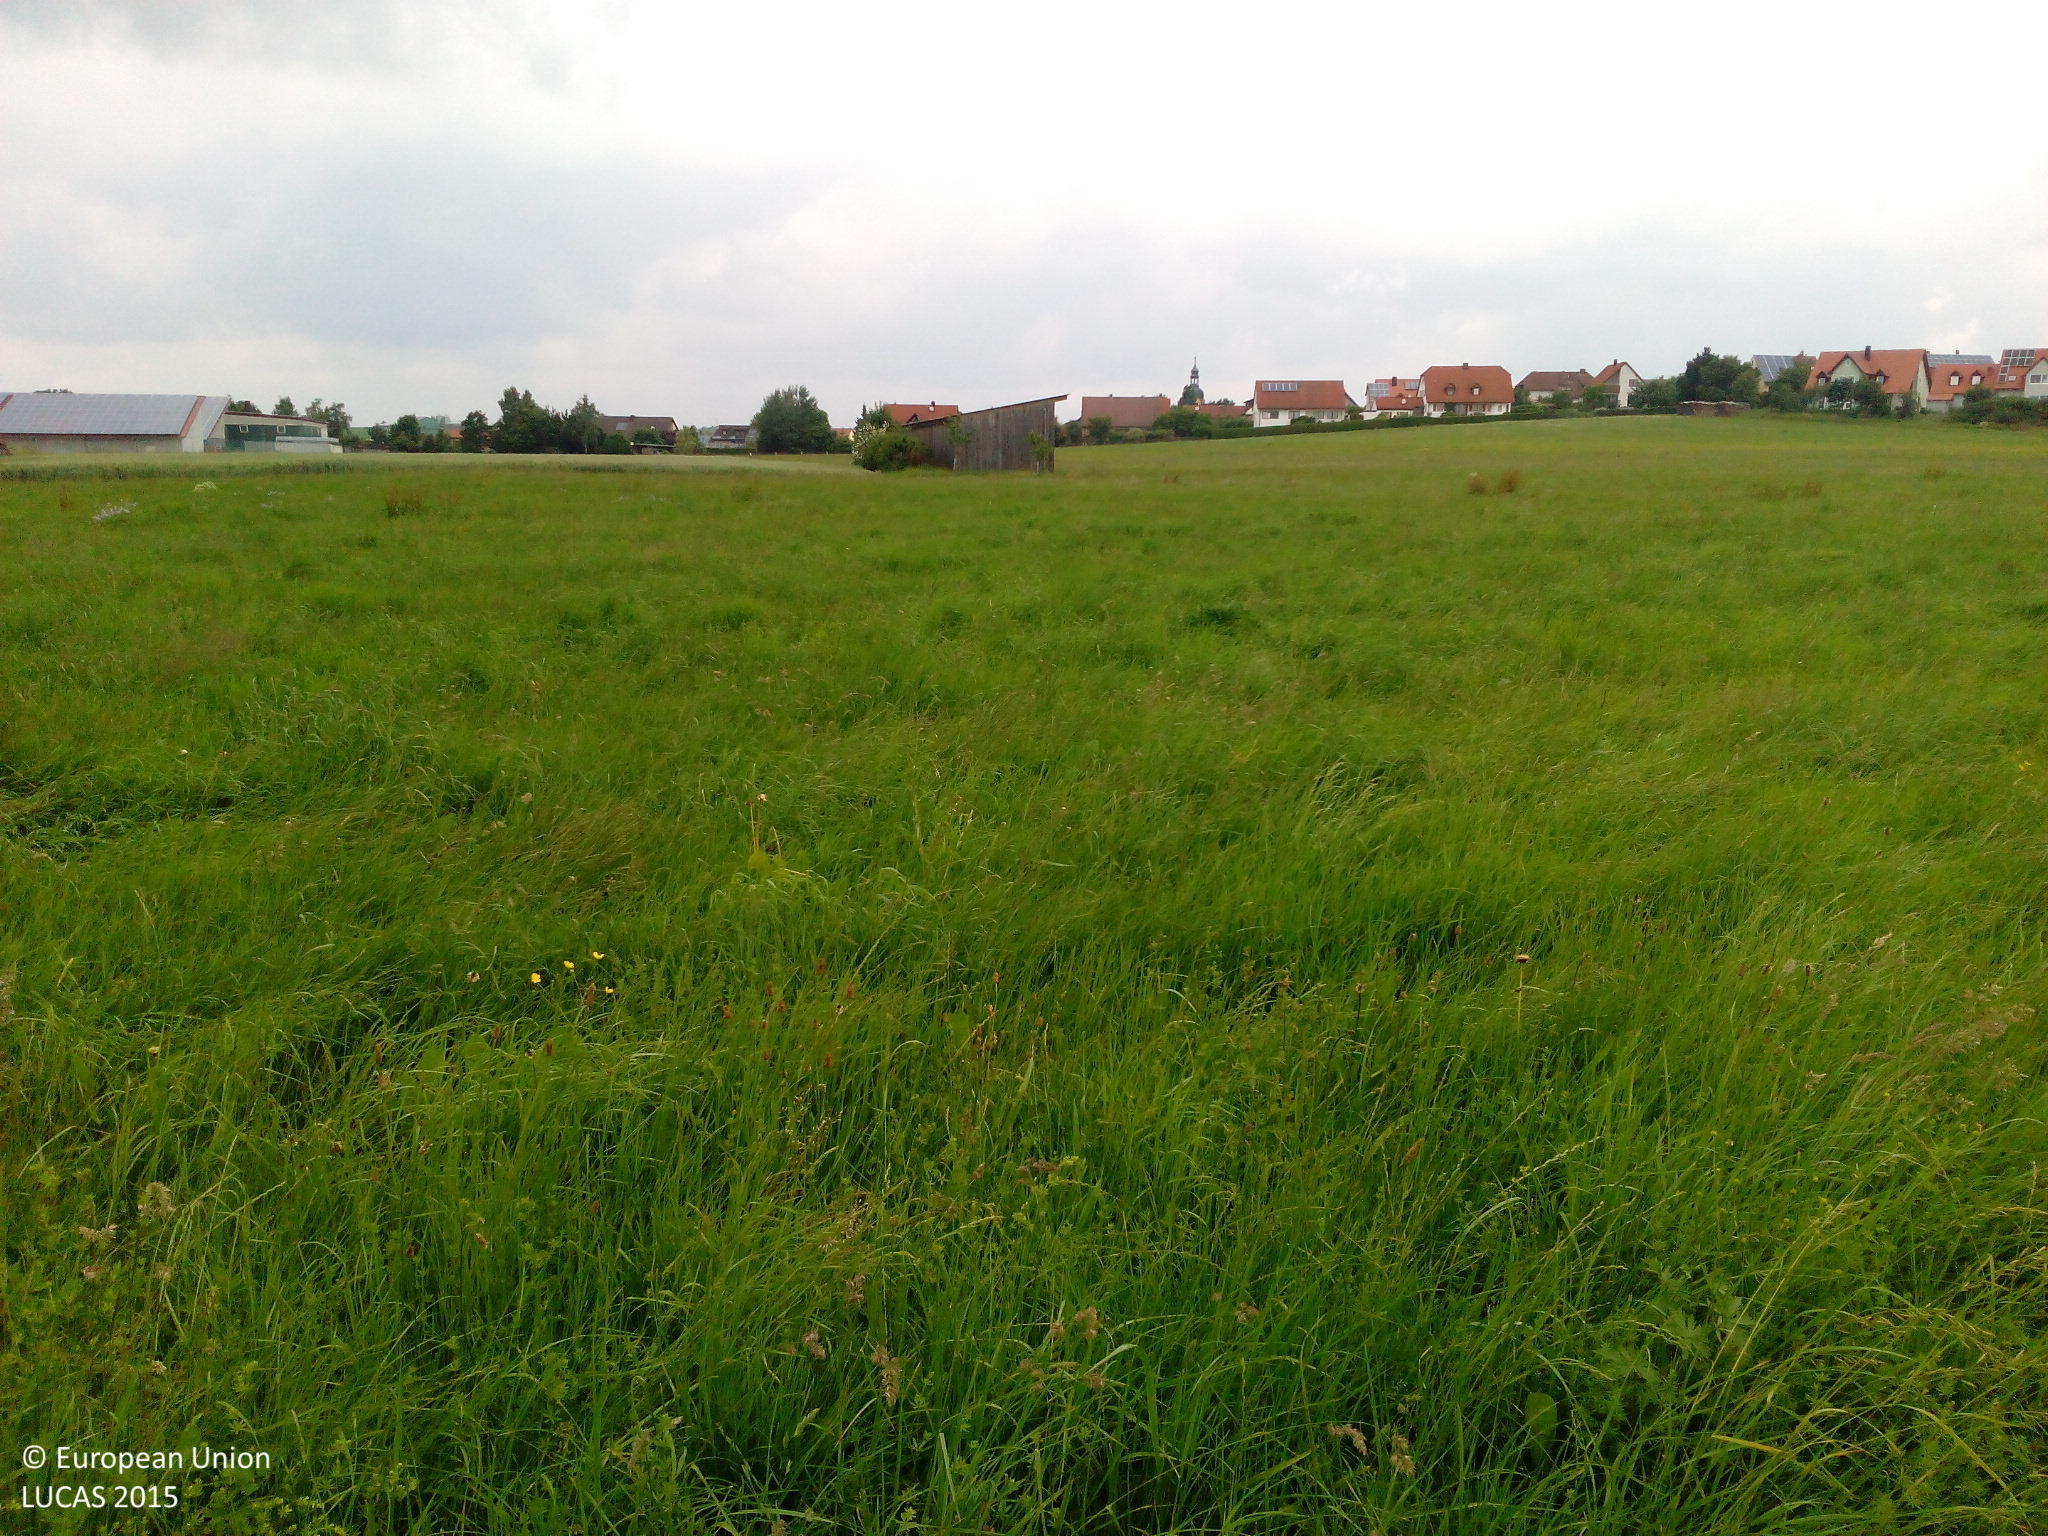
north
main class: Grassland
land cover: Grassland without tree/shrub cover
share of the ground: > 75 %
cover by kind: herbaceous plants 90 %, unconsolidated bare surface 10 %
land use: Agriculture (excluding fallow land and kitchen gardens)
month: June
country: DE
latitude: 49.0656
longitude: 10.8893
